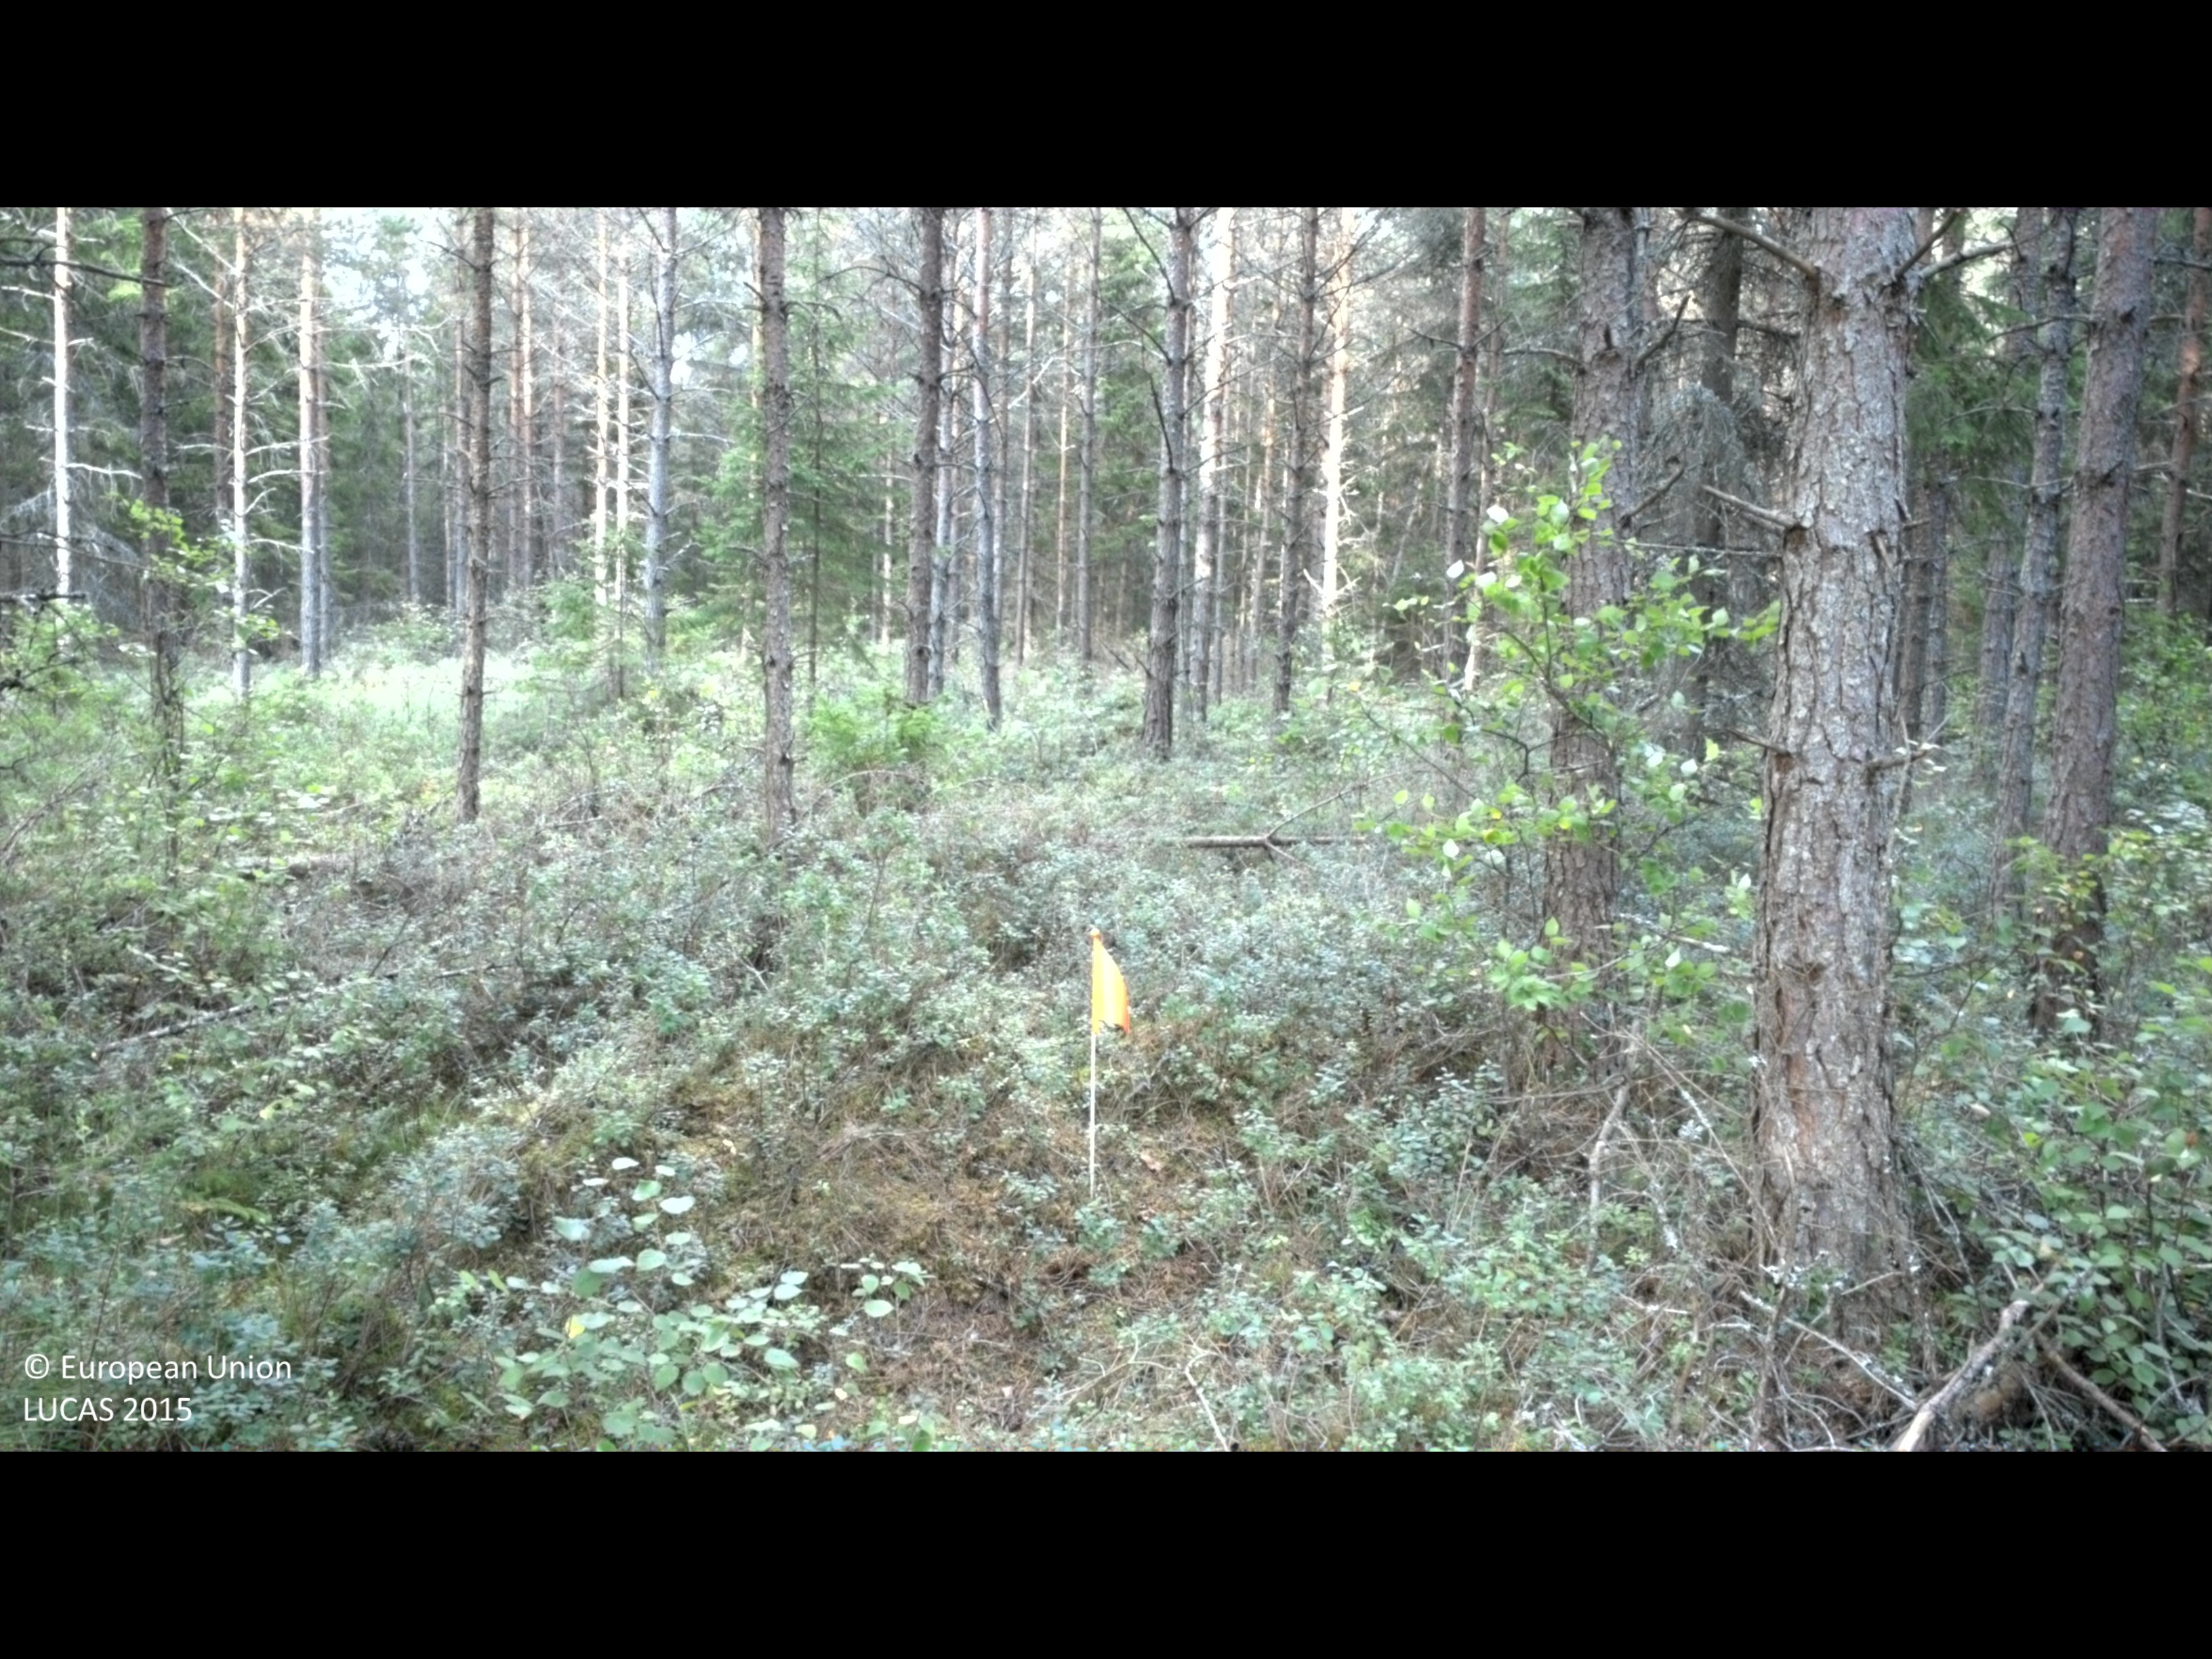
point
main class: Woodland
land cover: Pine dominated coniferous woodland
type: boreal forest
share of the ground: > 75 %
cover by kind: coniferous forest trees 75 %, shrubs 25 %
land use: Forestry
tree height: > 5 m
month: August
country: SE
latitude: 57.2270
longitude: 13.8884
